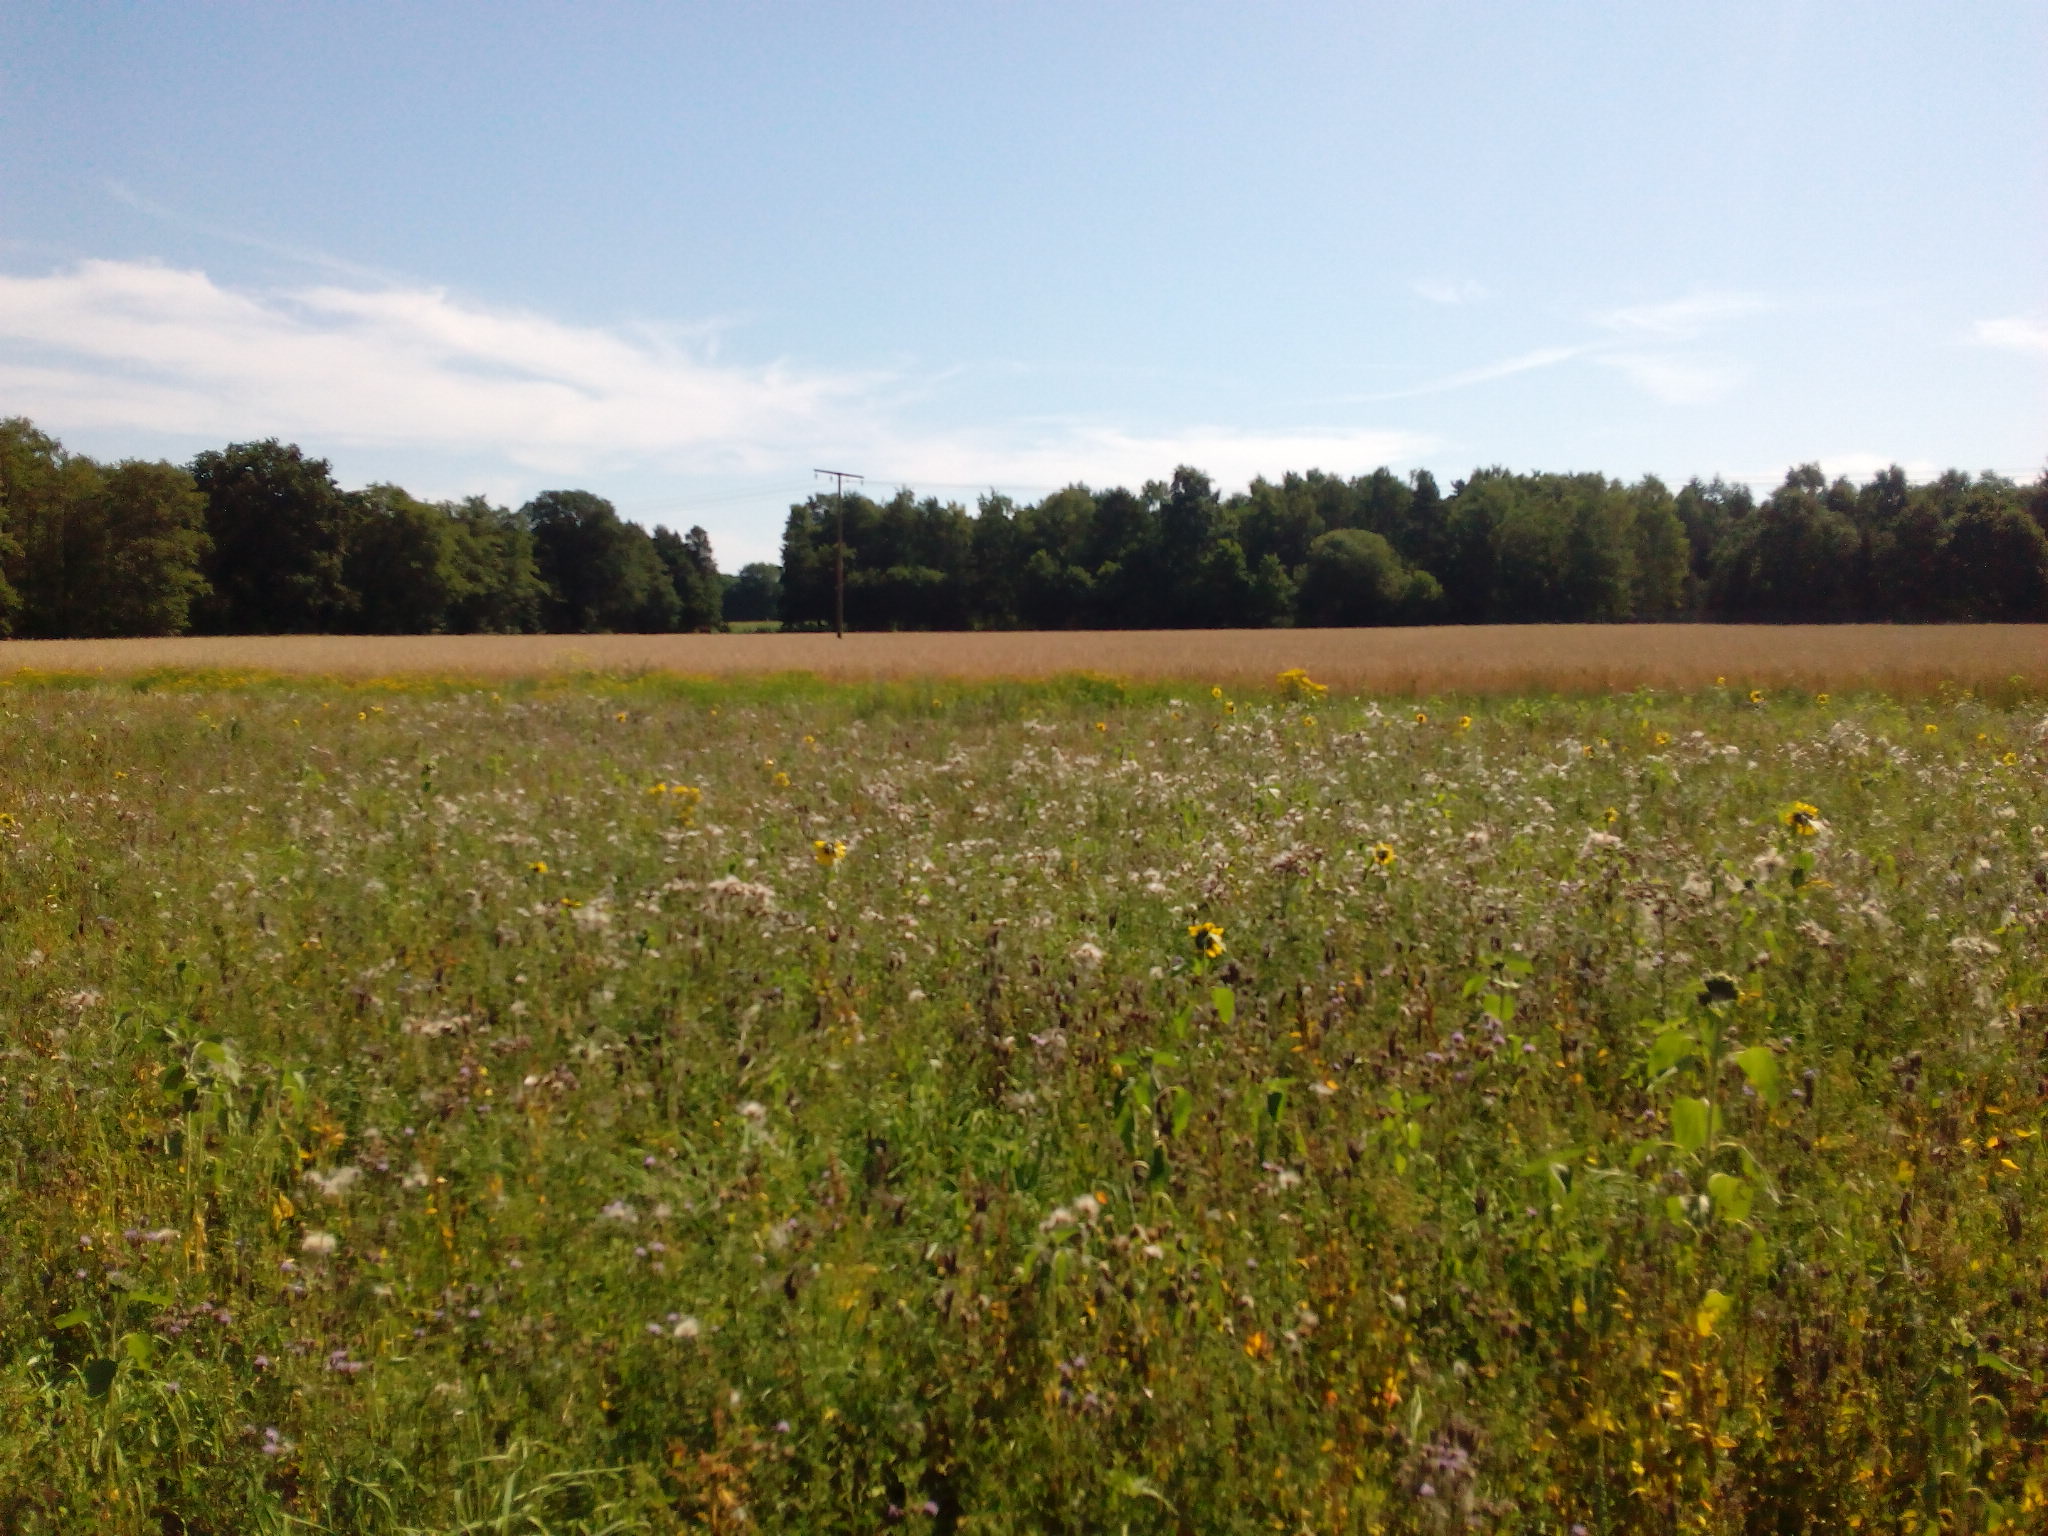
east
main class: Grassland
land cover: Grassland without tree/shrub cover
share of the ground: > 75 %
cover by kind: herbaceous plants 100 %
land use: Agriculture (excluding fallow land and kitchen gardens)
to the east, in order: Grassland without tree/shrub cover; Rye; Electric lines; Rye; Lines of trees; Ditches and canals; Grass margins; Tracks; Fences; Tracks; Broadleaved woodland; Inland fresh running water
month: August
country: DE
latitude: 52.4853
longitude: 9.9264
